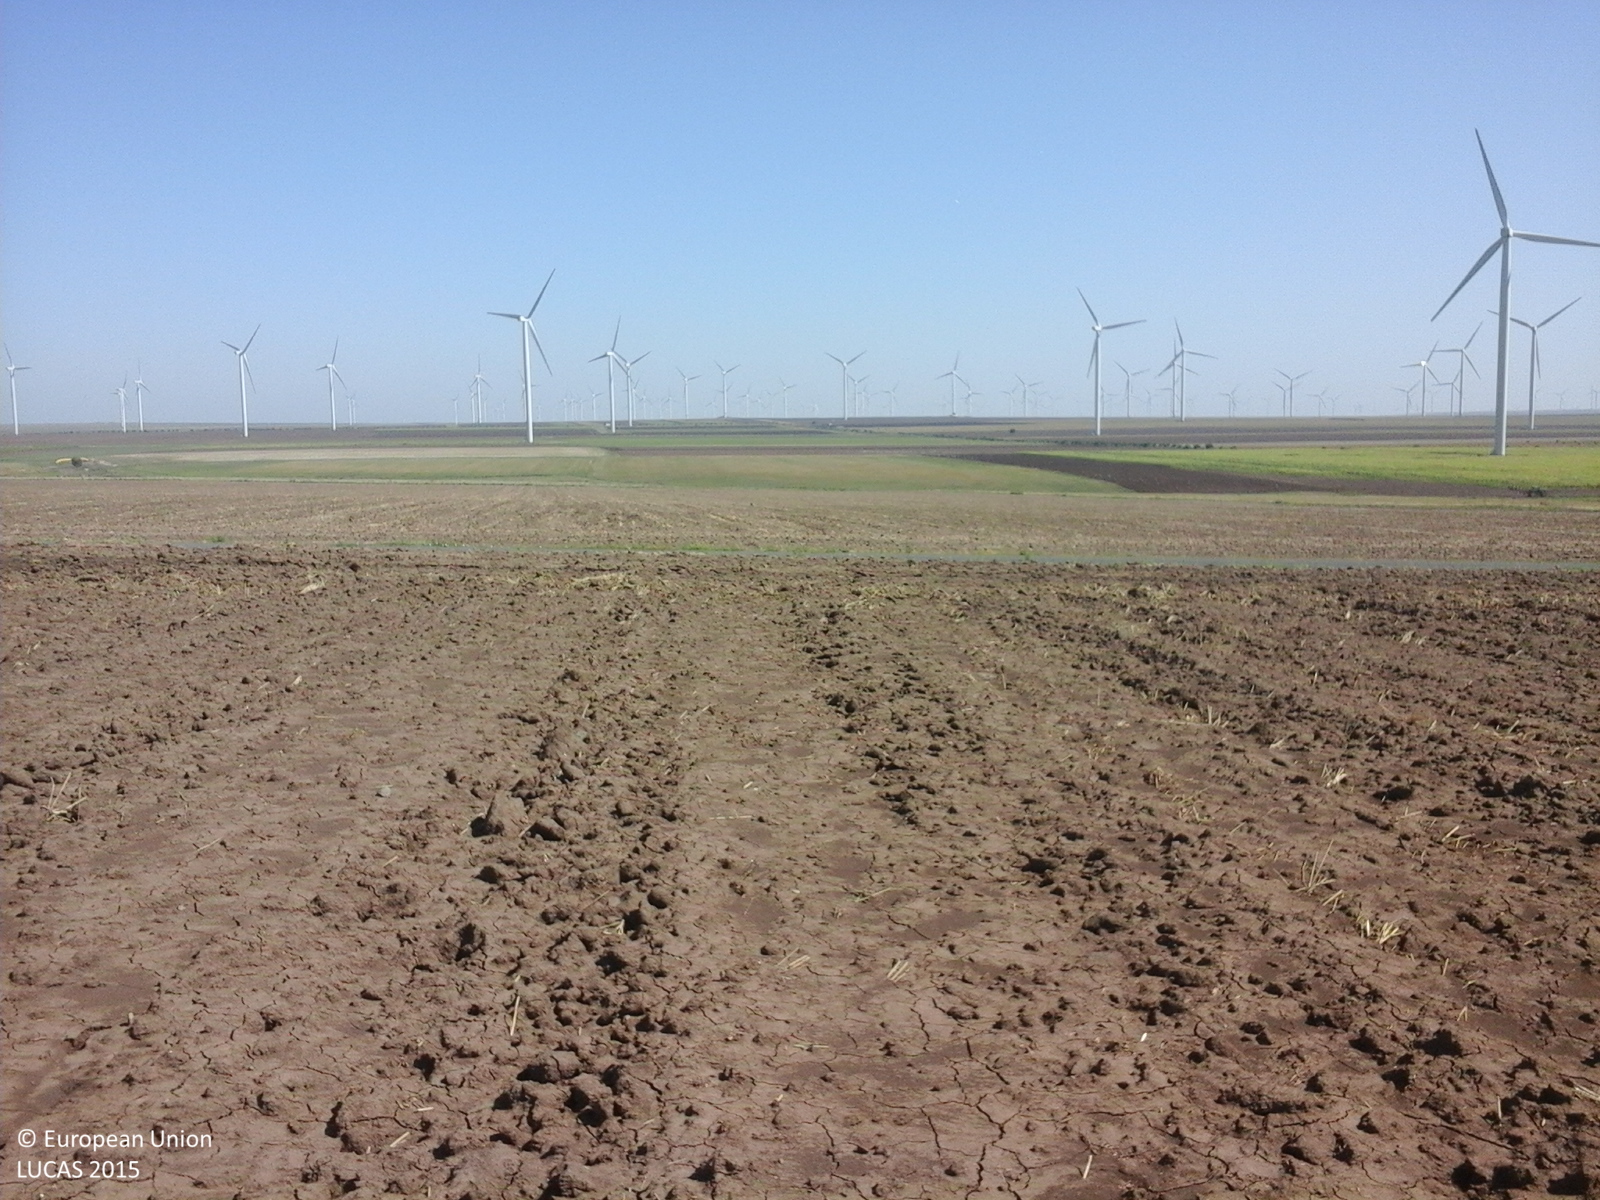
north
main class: Cropland
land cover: Common wheat
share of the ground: < 10 %
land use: Agriculture (excluding fallow land and kitchen gardens)
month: August
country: RO
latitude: 44.5674
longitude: 28.5211
